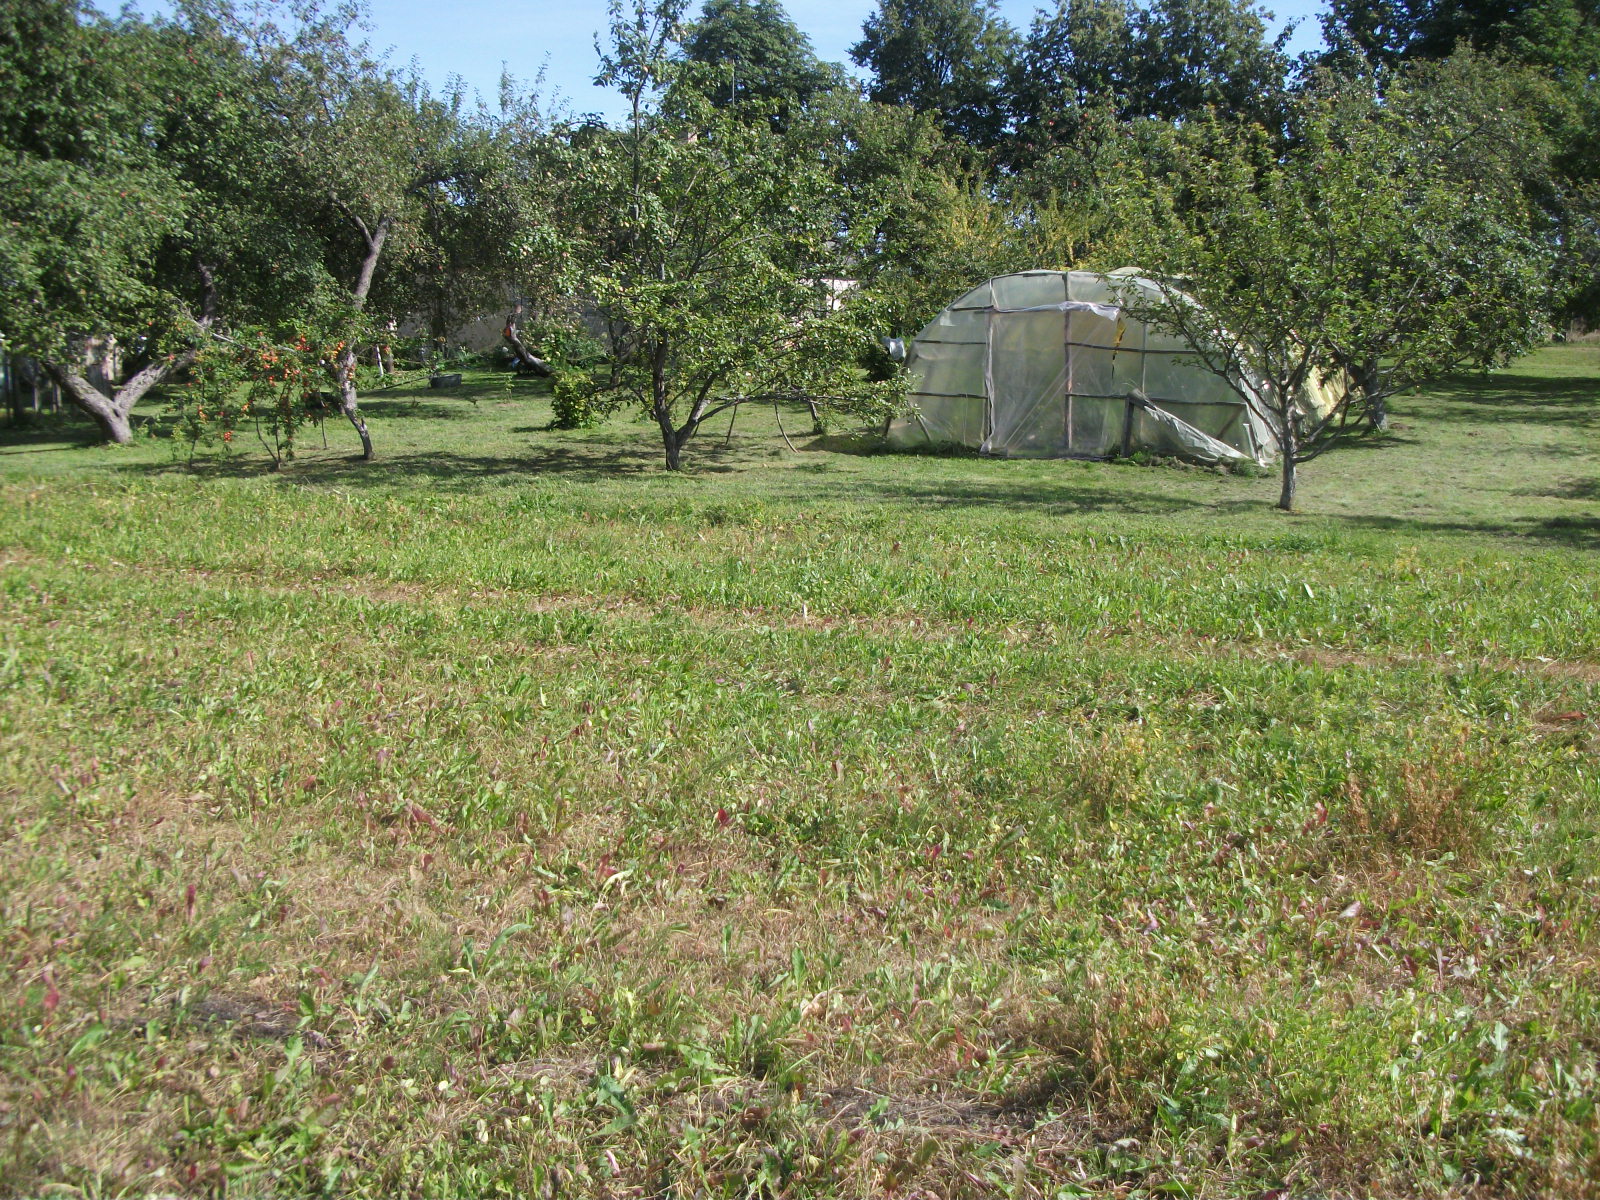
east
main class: Grassland
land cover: Grassland without tree/shrub cover
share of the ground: > 75 %
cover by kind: herbaceous plants 100 %
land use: Agriculture (excluding fallow land and kitchen gardens)
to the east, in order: Grassland without tree/shrub cover; Apple fruit; Artificial constructions in urban areas; Grassland without tree/shrub cover; Fences; Grassland without tree/shrub cover; Fences; Abandoned hedges; Ditches and canals; Other mixed woodland; Shruby margins; Grassland without tree/shrub cover
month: August
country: LV
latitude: 56.1828
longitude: 26.3029
